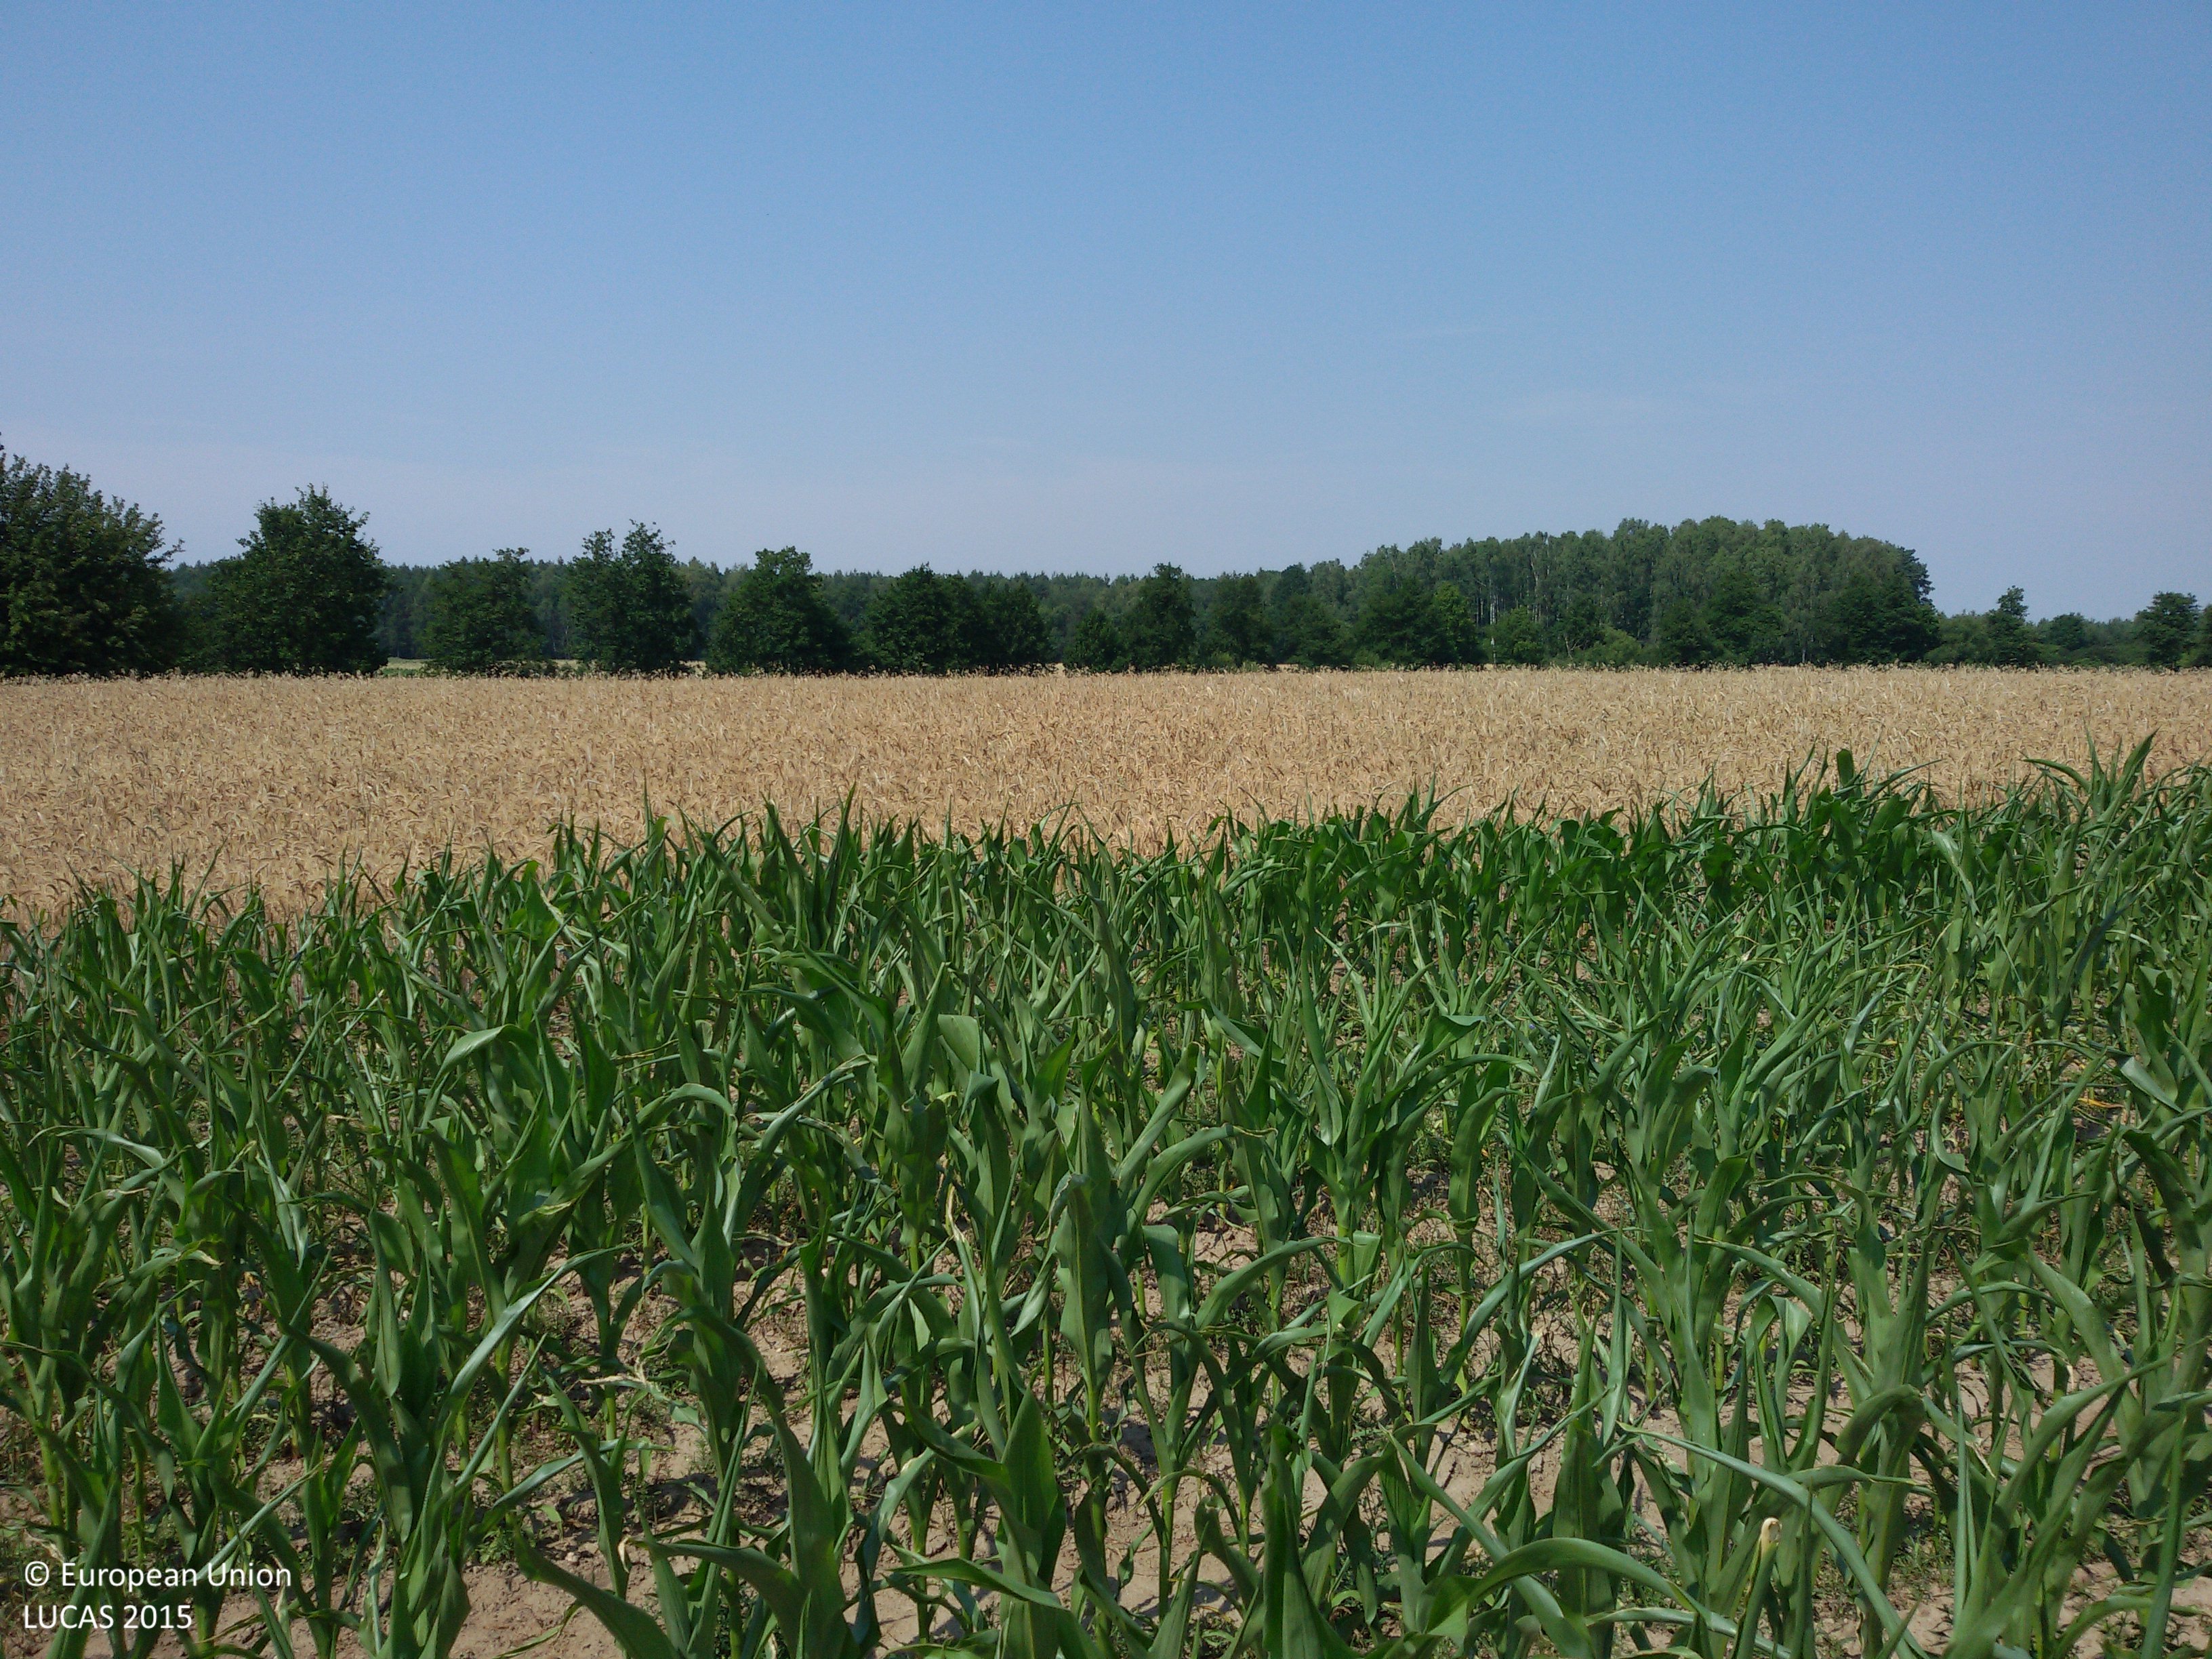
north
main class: Cropland
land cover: Maize
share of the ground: 50 - 75 %
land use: Agriculture (excluding fallow land and kitchen gardens)
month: July
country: PL
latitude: 53.2826
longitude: 17.7075
